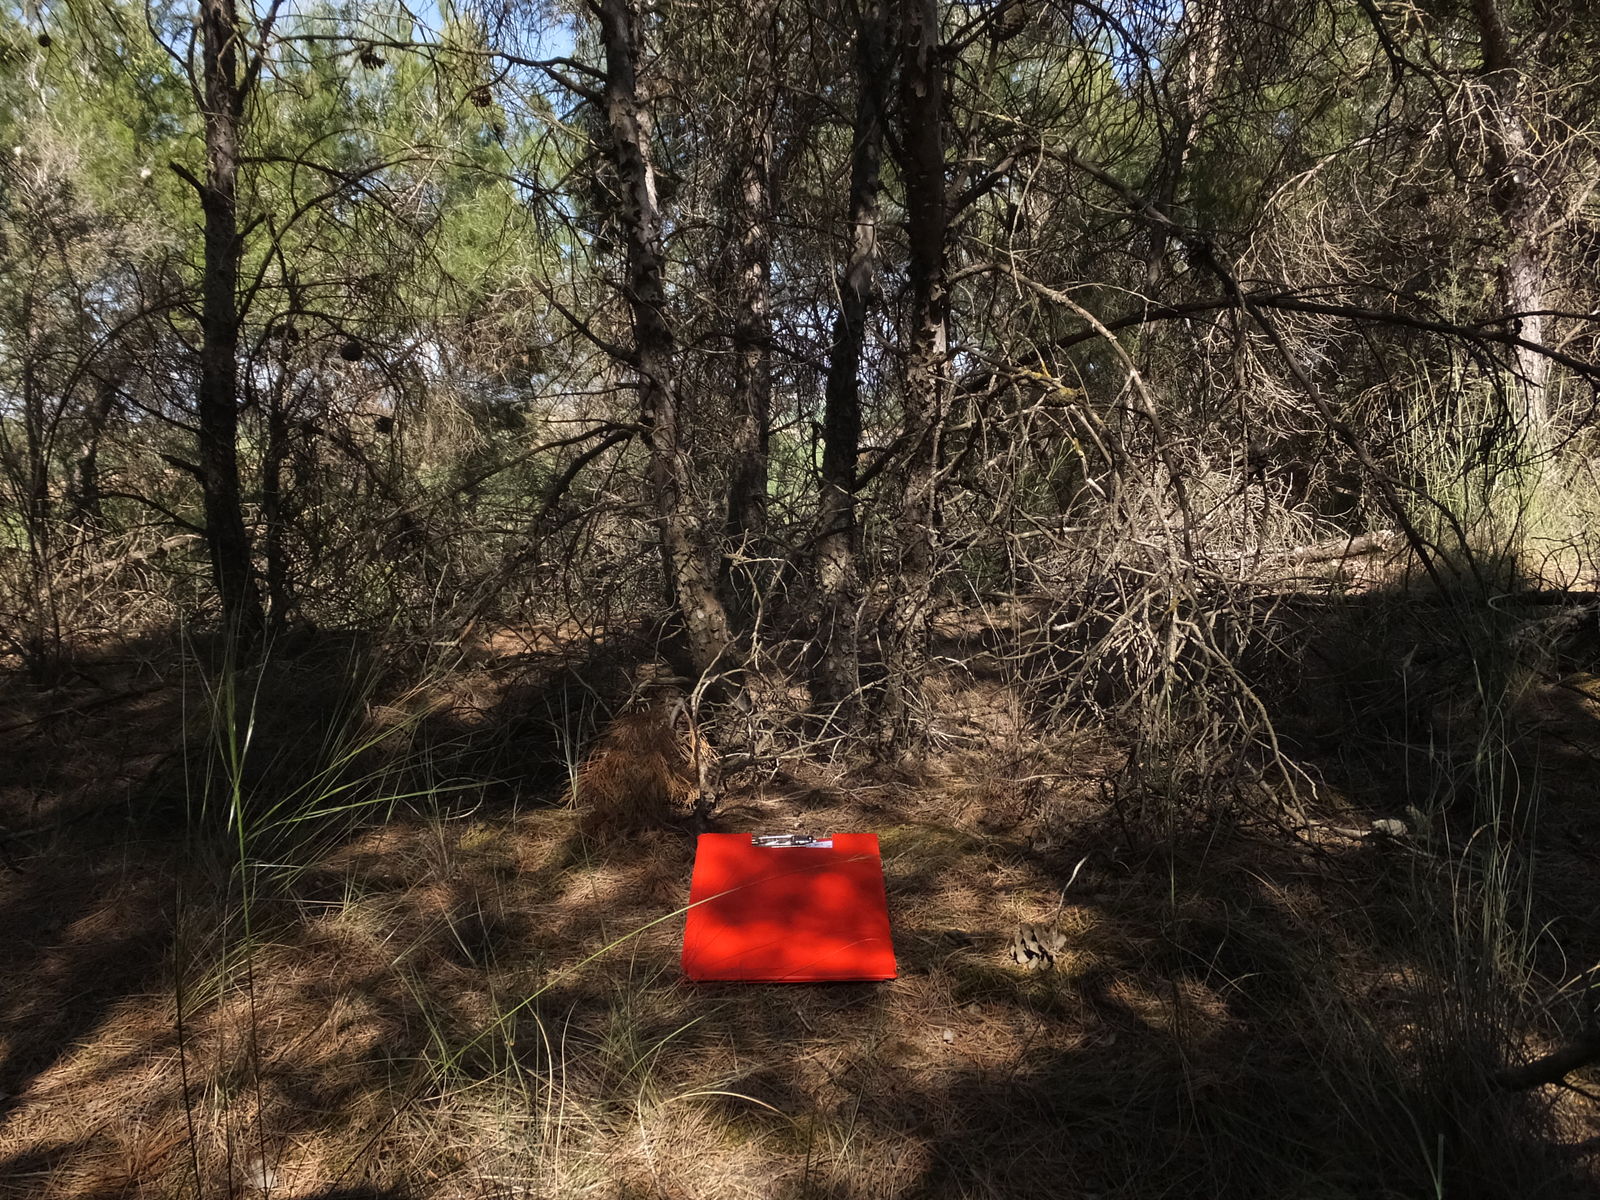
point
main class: Woodland
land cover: Pine dominated mixed woodland
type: coniferous forest of the mediterranean region
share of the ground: > 75 %
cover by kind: coniferous forest trees 50 %, broadleaved forest trees 25 %, herbaceous plants 25 %
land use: Forestry
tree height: > 5 m
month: May
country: ES
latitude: 41.6845
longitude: 0.3630
